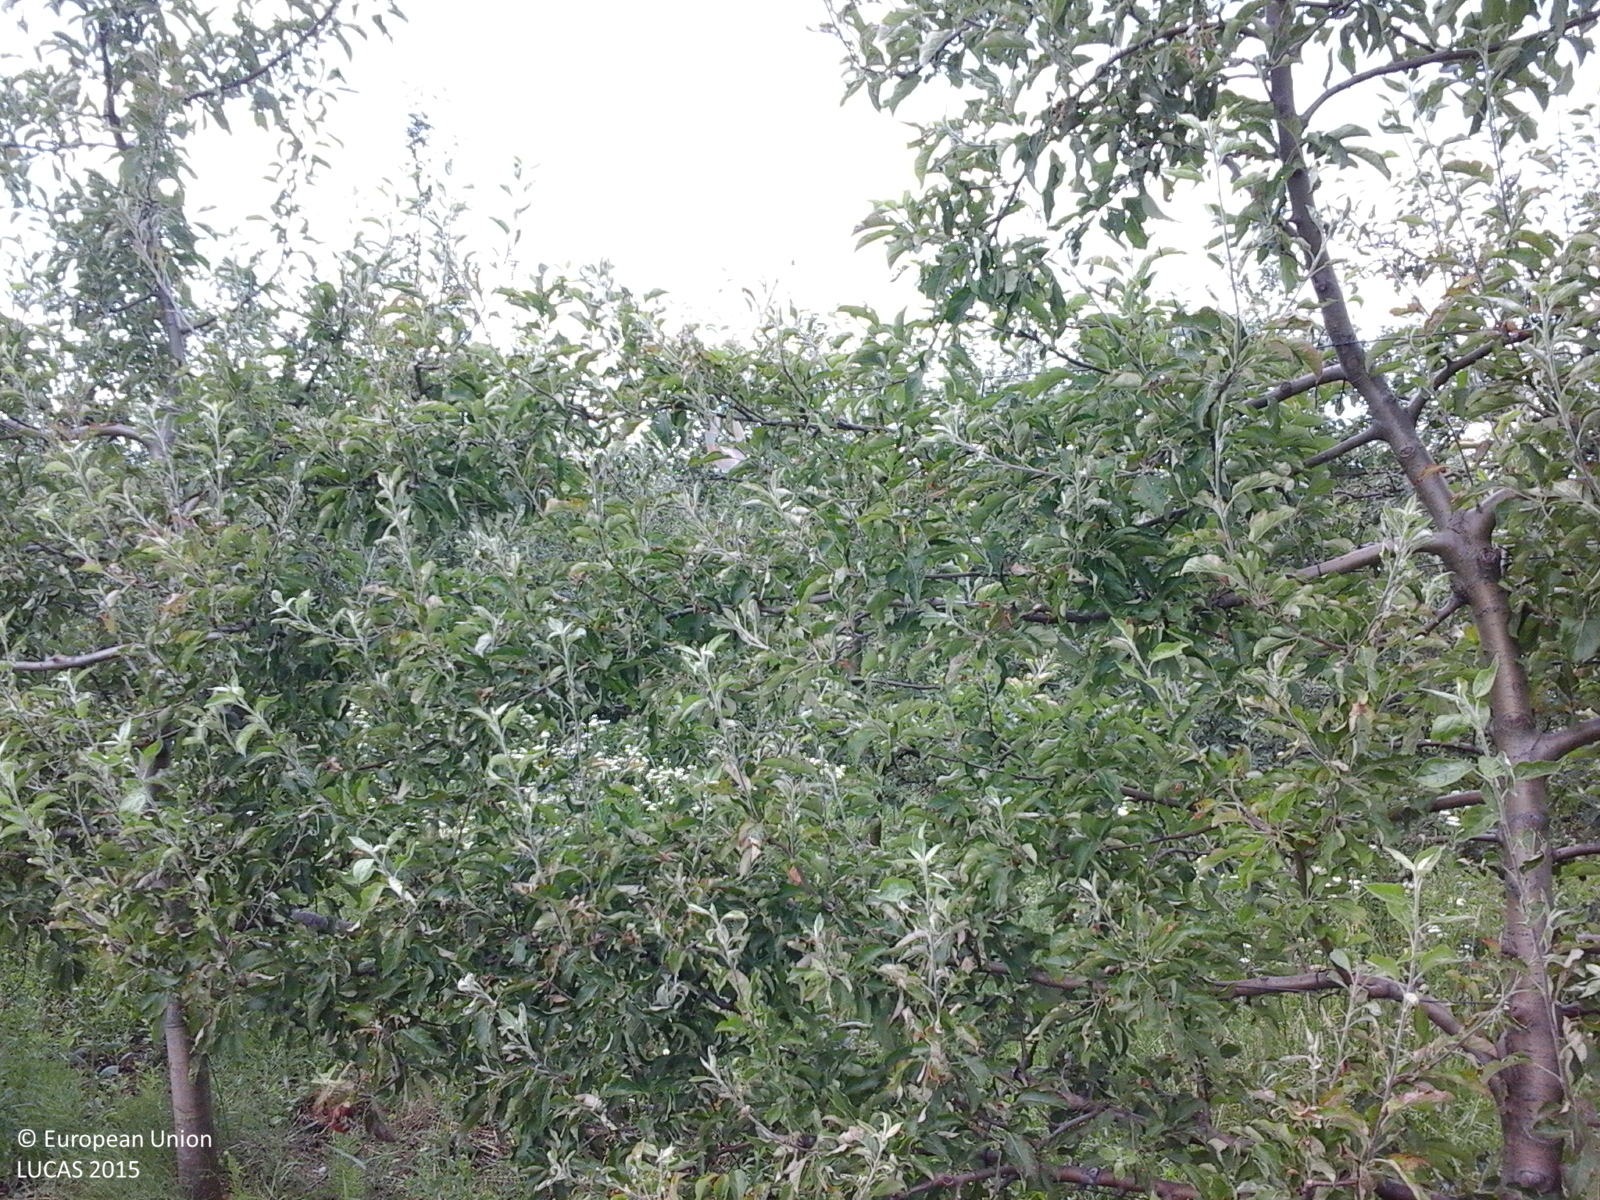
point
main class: Cropland
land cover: Apple fruit
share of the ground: 50 - 75 %
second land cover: Grassland without tree/shrub cover
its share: > 75 %
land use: Agriculture (excluding fallow land and kitchen gardens)
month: June
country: RO
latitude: 47.5179
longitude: 26.2707
